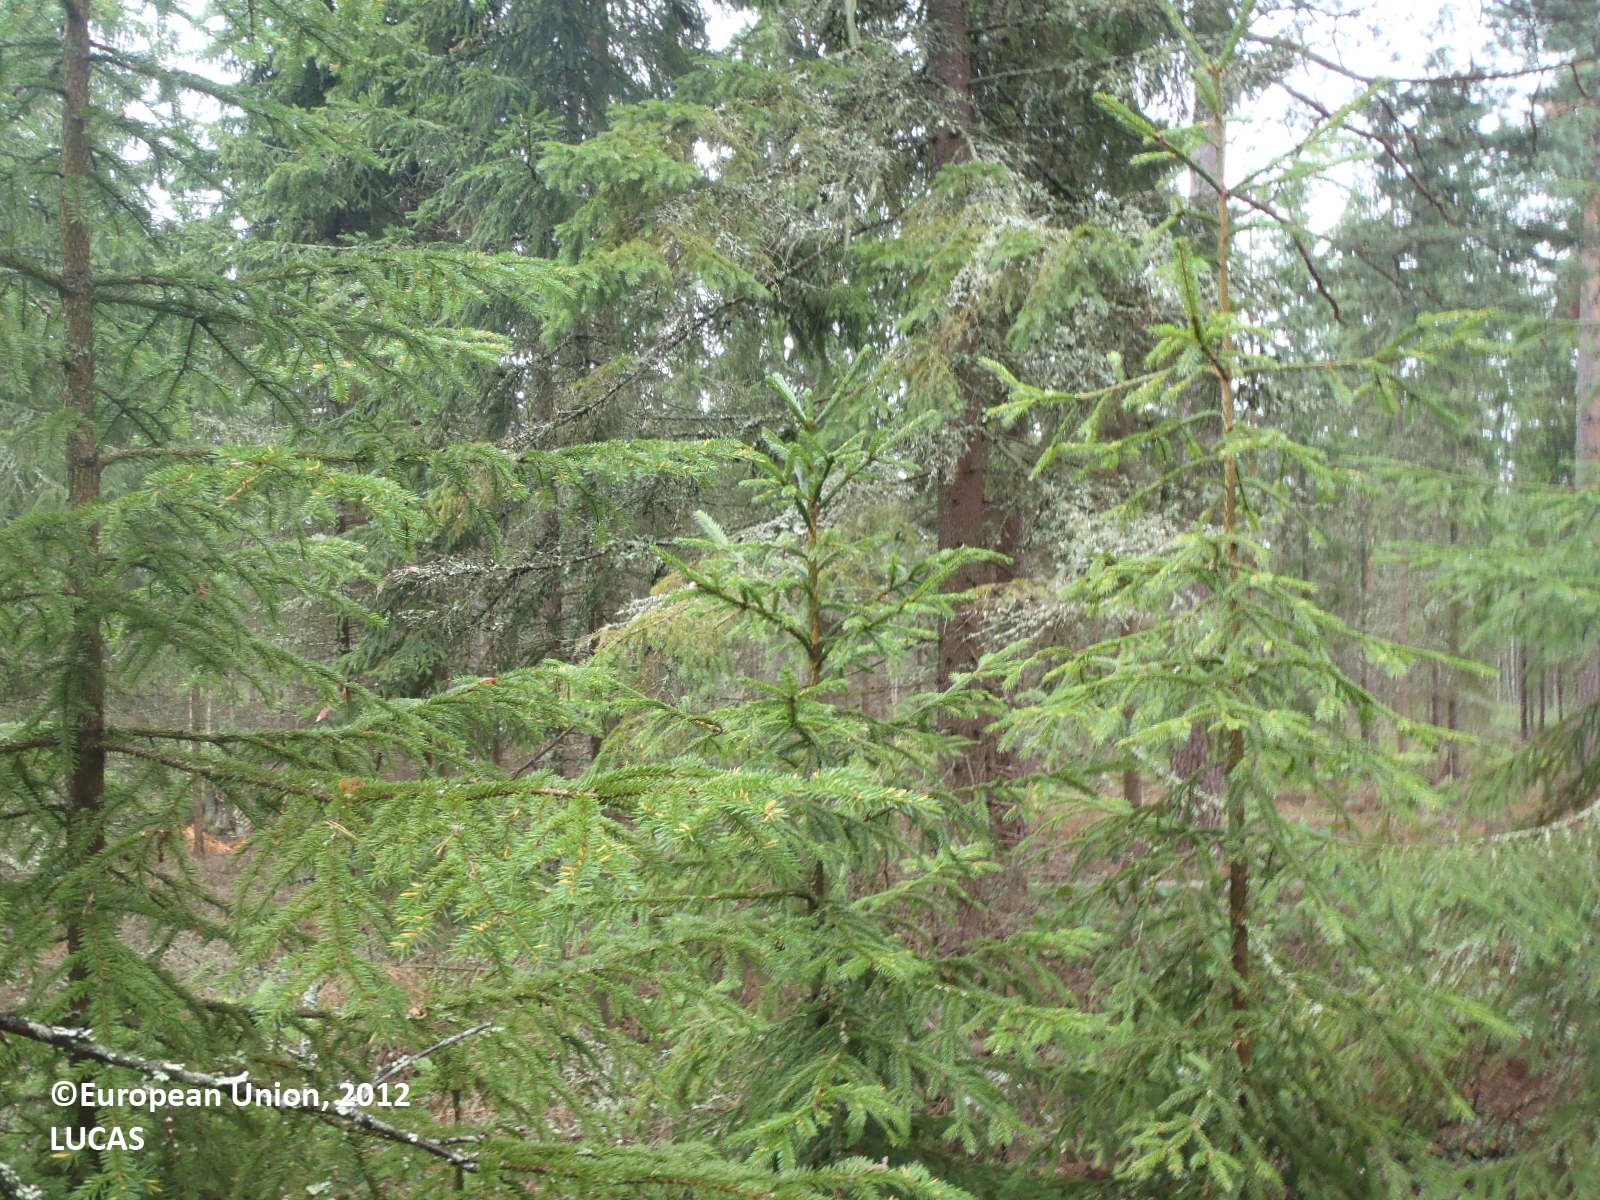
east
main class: Woodland
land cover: Spruce dominated mixed woodland
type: boreal forest
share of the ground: > 75 %
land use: Forestry
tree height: > 5 m
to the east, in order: Spruce dominated mixed woodland; Lichens and moss; Pine dominated mixed woodland; Grassland without tree/shrub cover; Ditches and canals; Grass margins; Shrubland with sparse tree cover
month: July
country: FI
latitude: 60.7457
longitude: 21.7437
